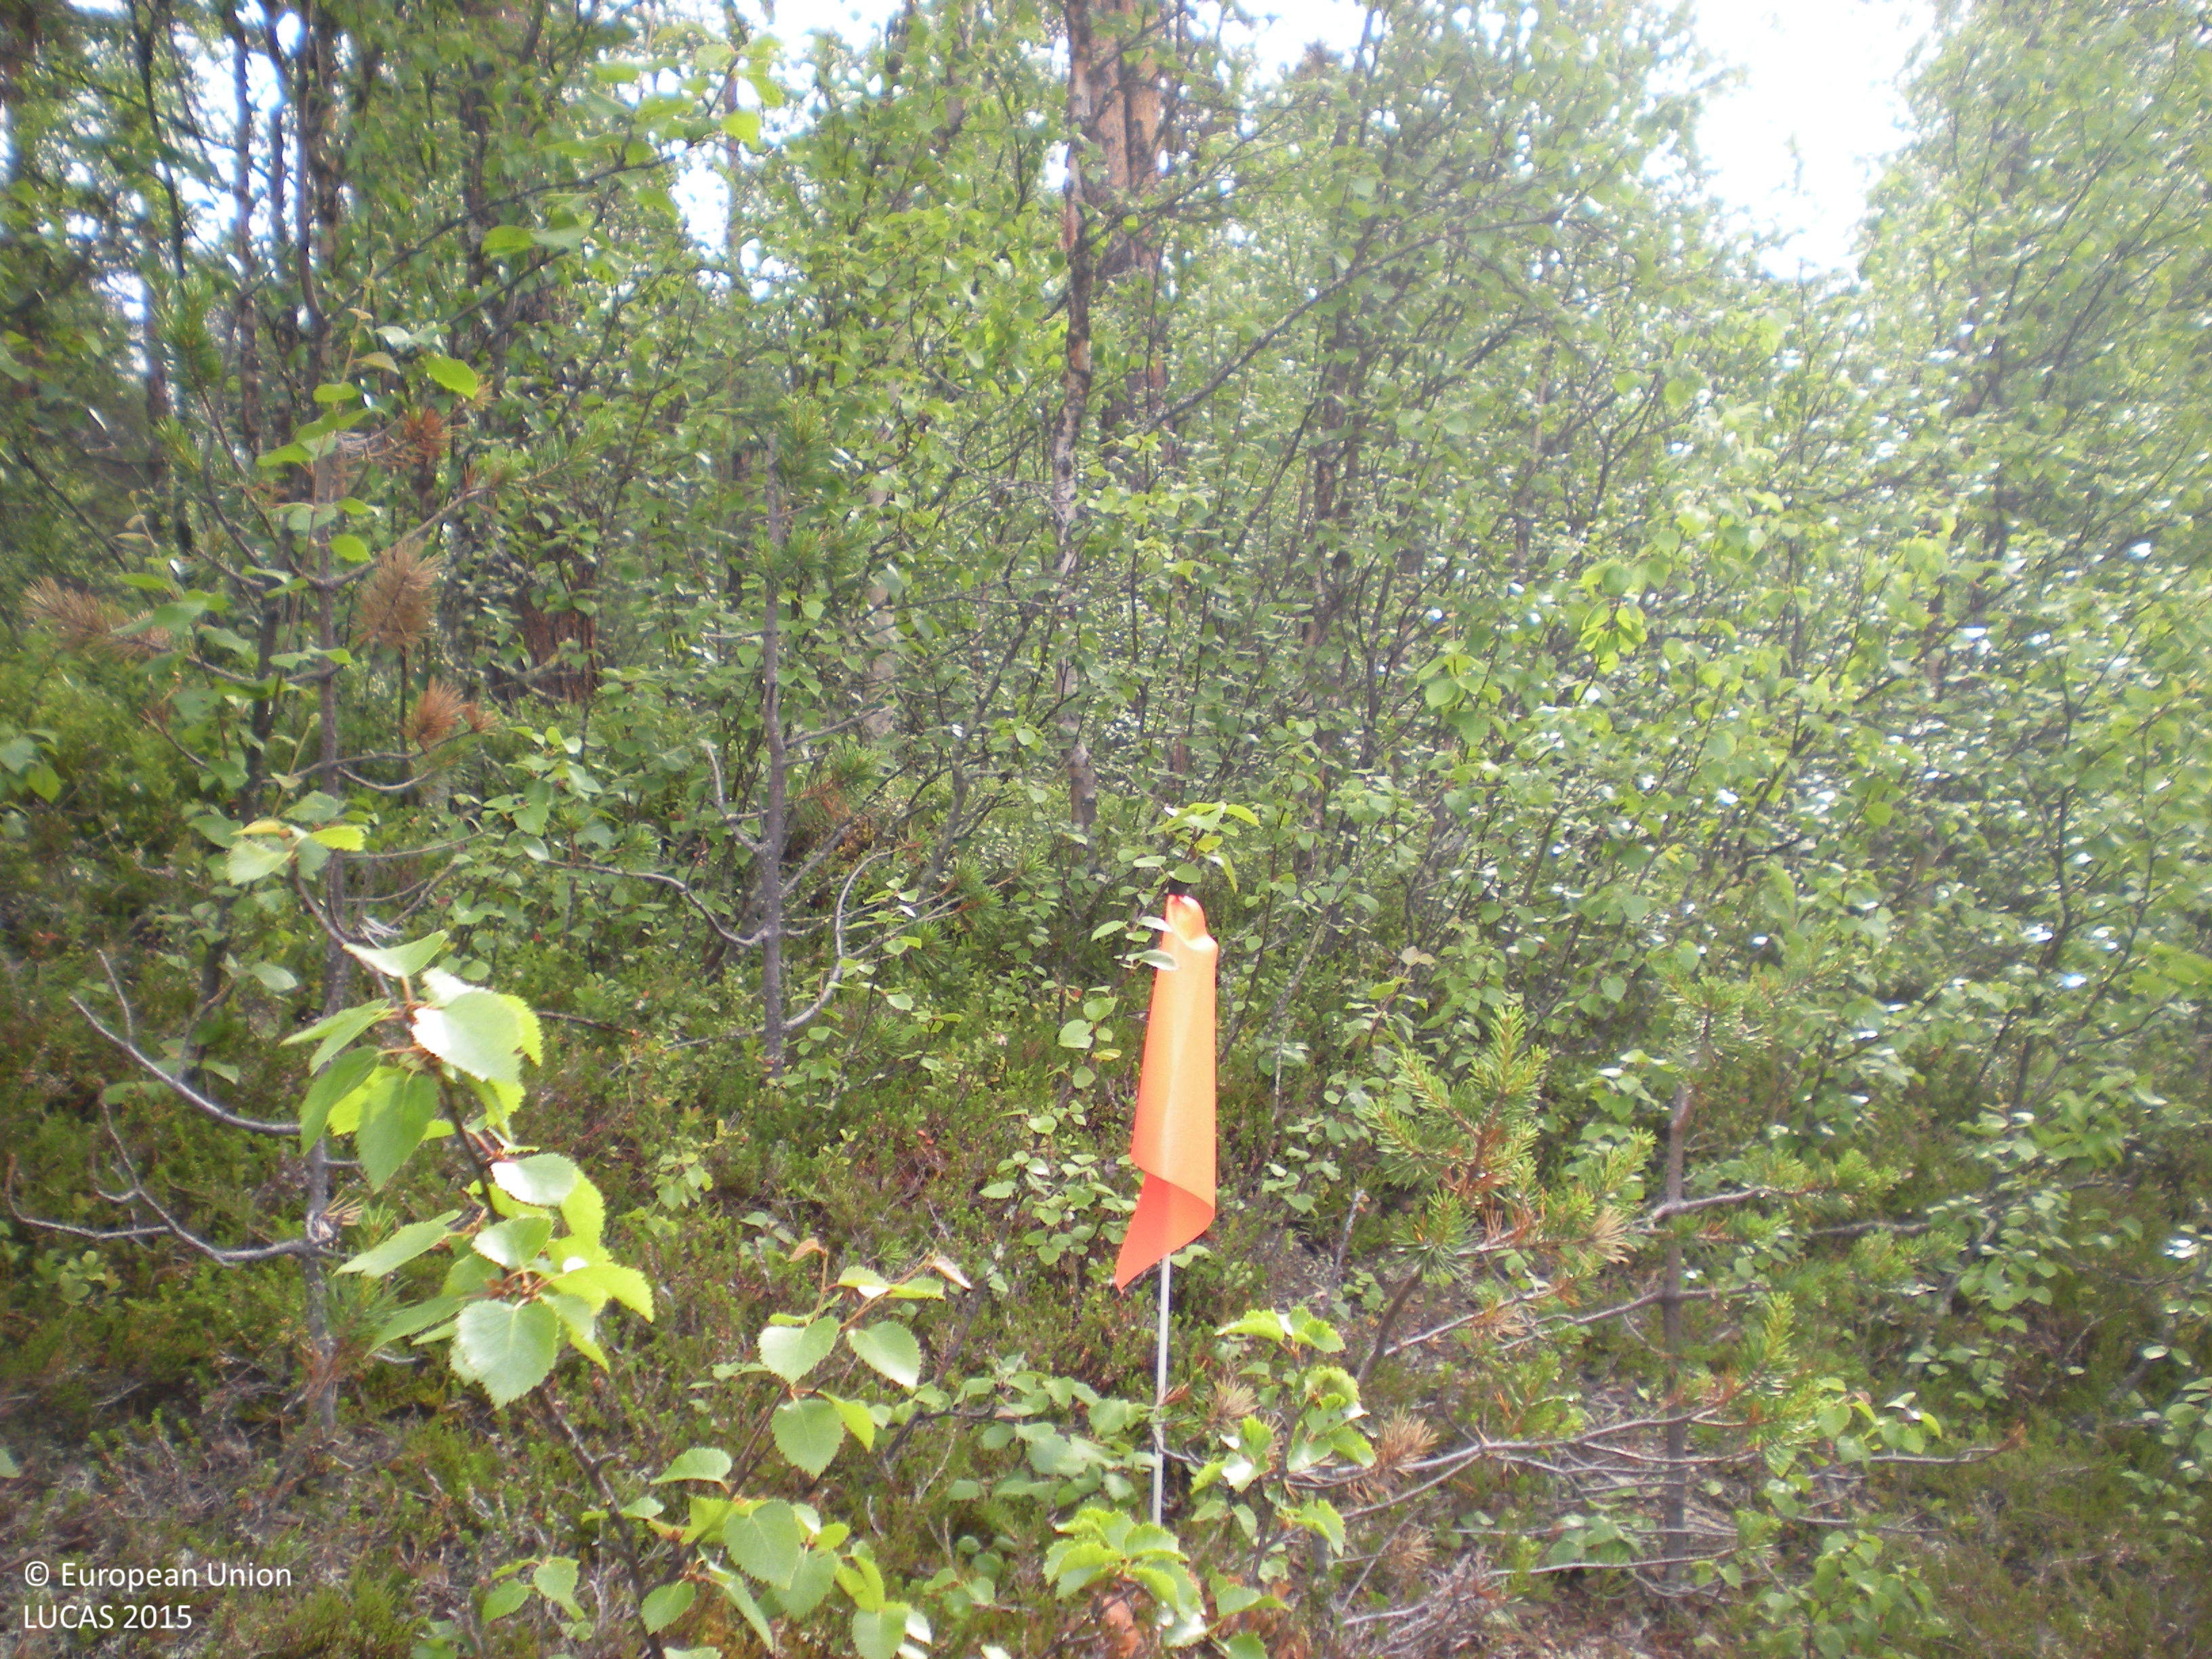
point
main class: Woodland
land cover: Broadleaved woodland
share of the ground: 25 - 50 %
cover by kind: broadleaved forest trees 40 %, shrubs 40 %, lichens and mosses 10 %, coniferous forest trees 5 %, consolidated bare surface 5 %
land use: Forestry
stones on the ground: > 50 %
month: July
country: SE
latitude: 66.2422
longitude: 16.9620
